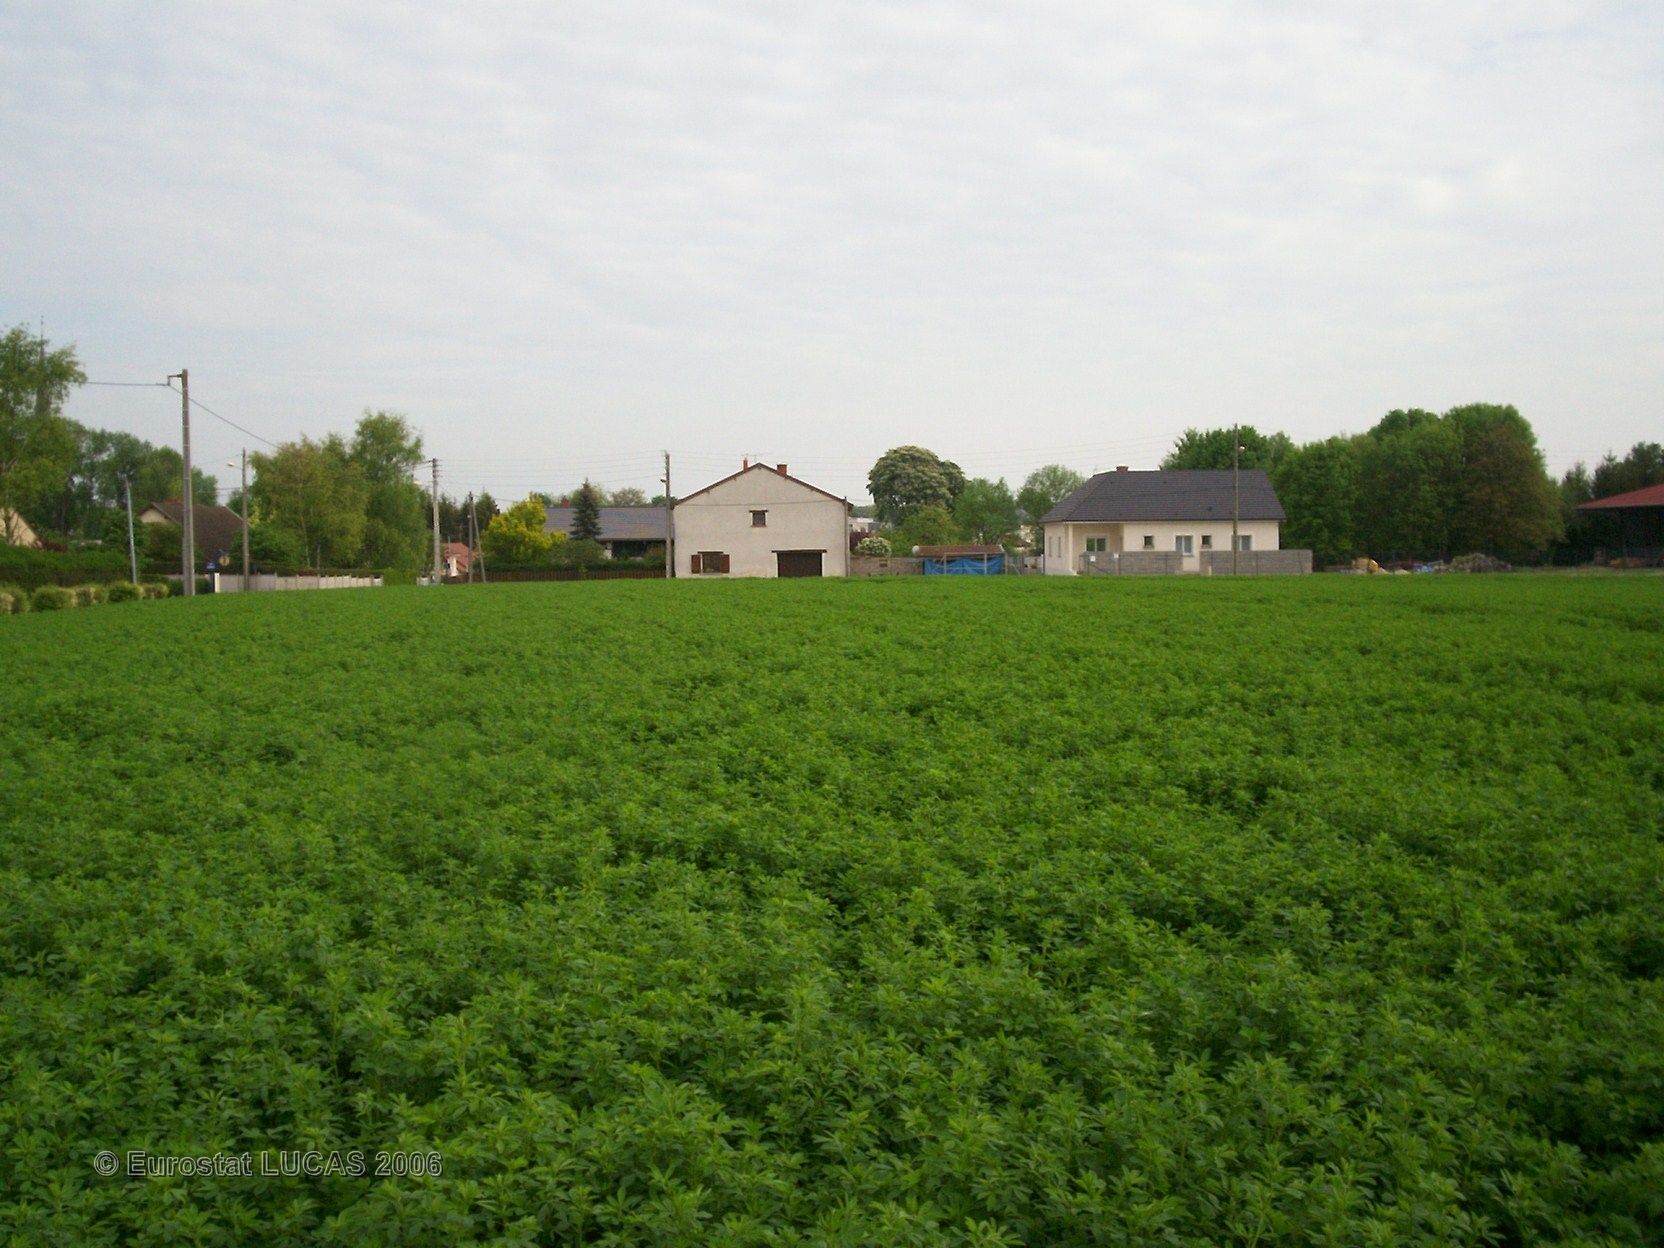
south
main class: Cropland
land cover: Lucerne
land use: Agriculture (excluding fallow land and kitchen gardens)
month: May
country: FR
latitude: 49.1433
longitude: 4.3620
